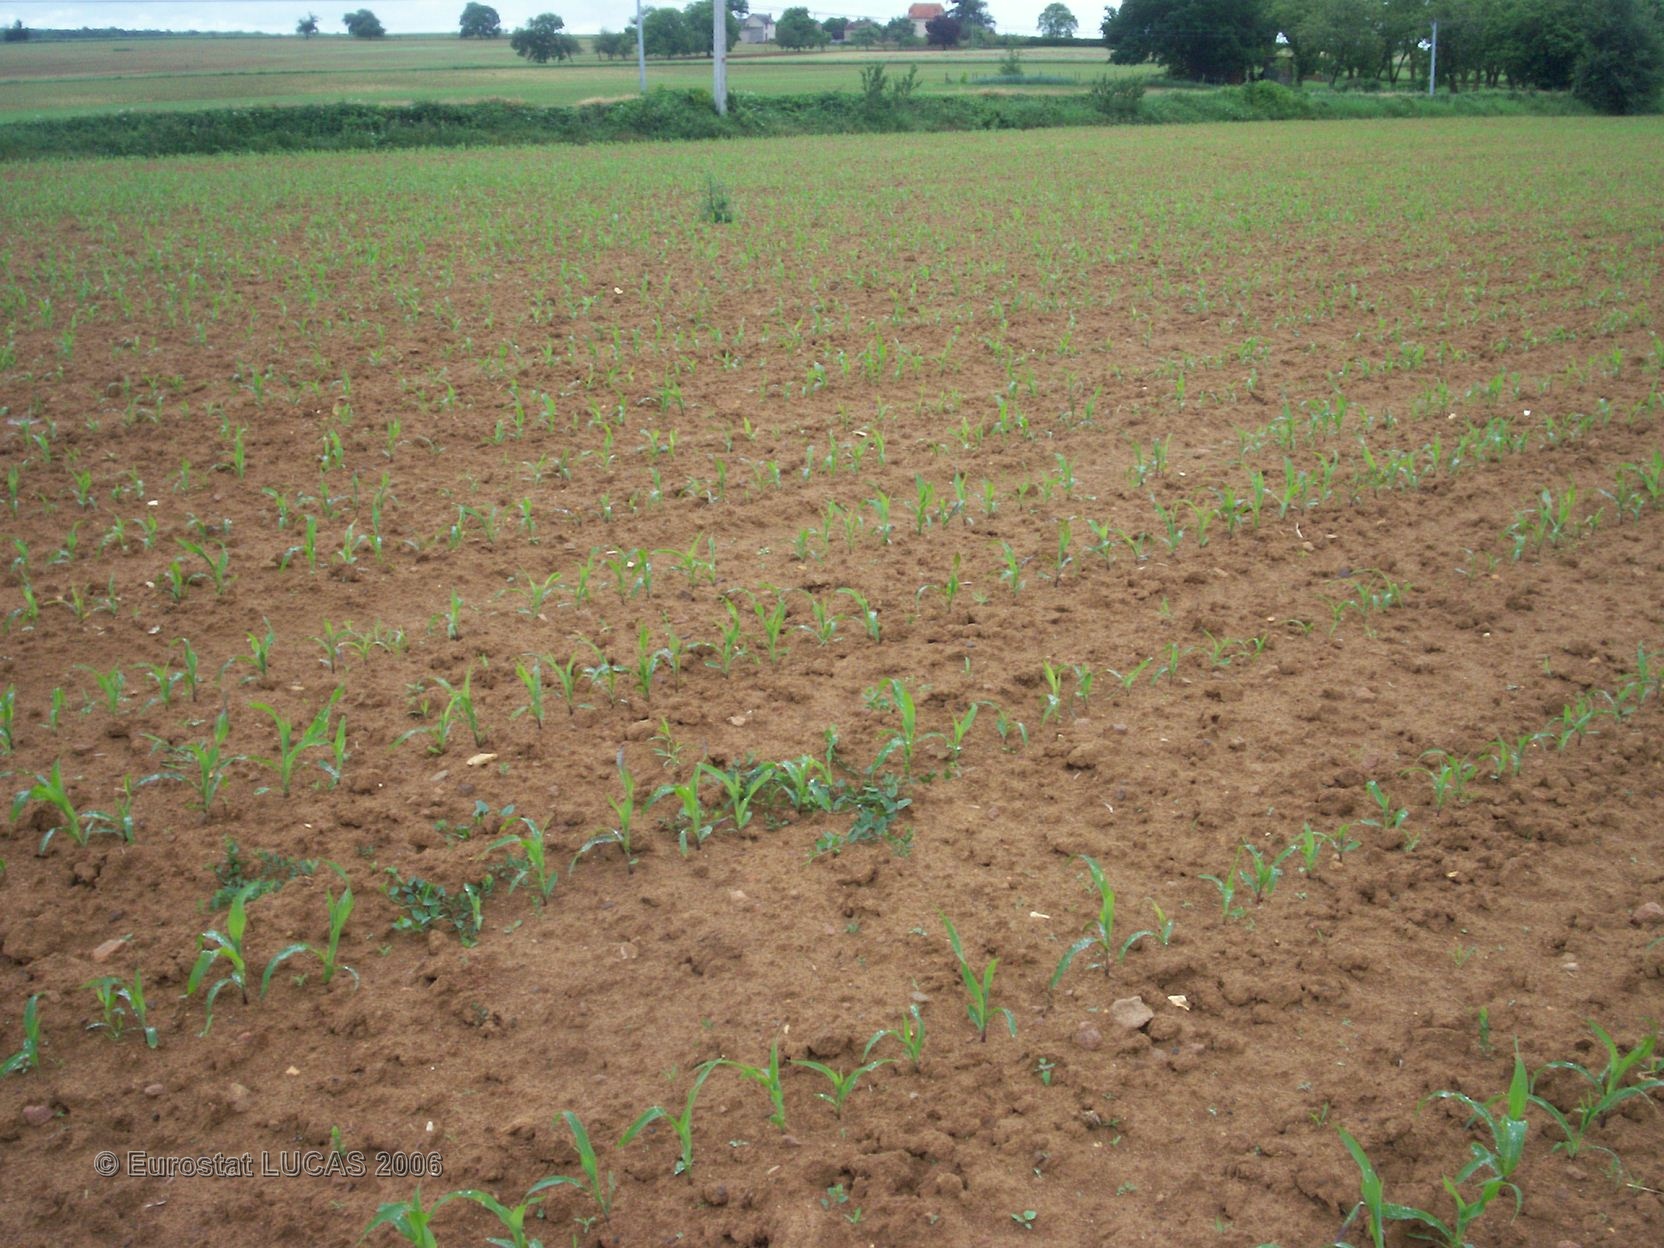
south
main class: Cropland
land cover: Maize
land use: Agriculture (excluding fallow land and kitchen gardens)
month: May
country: FR
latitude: 46.6845
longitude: 0.4501
